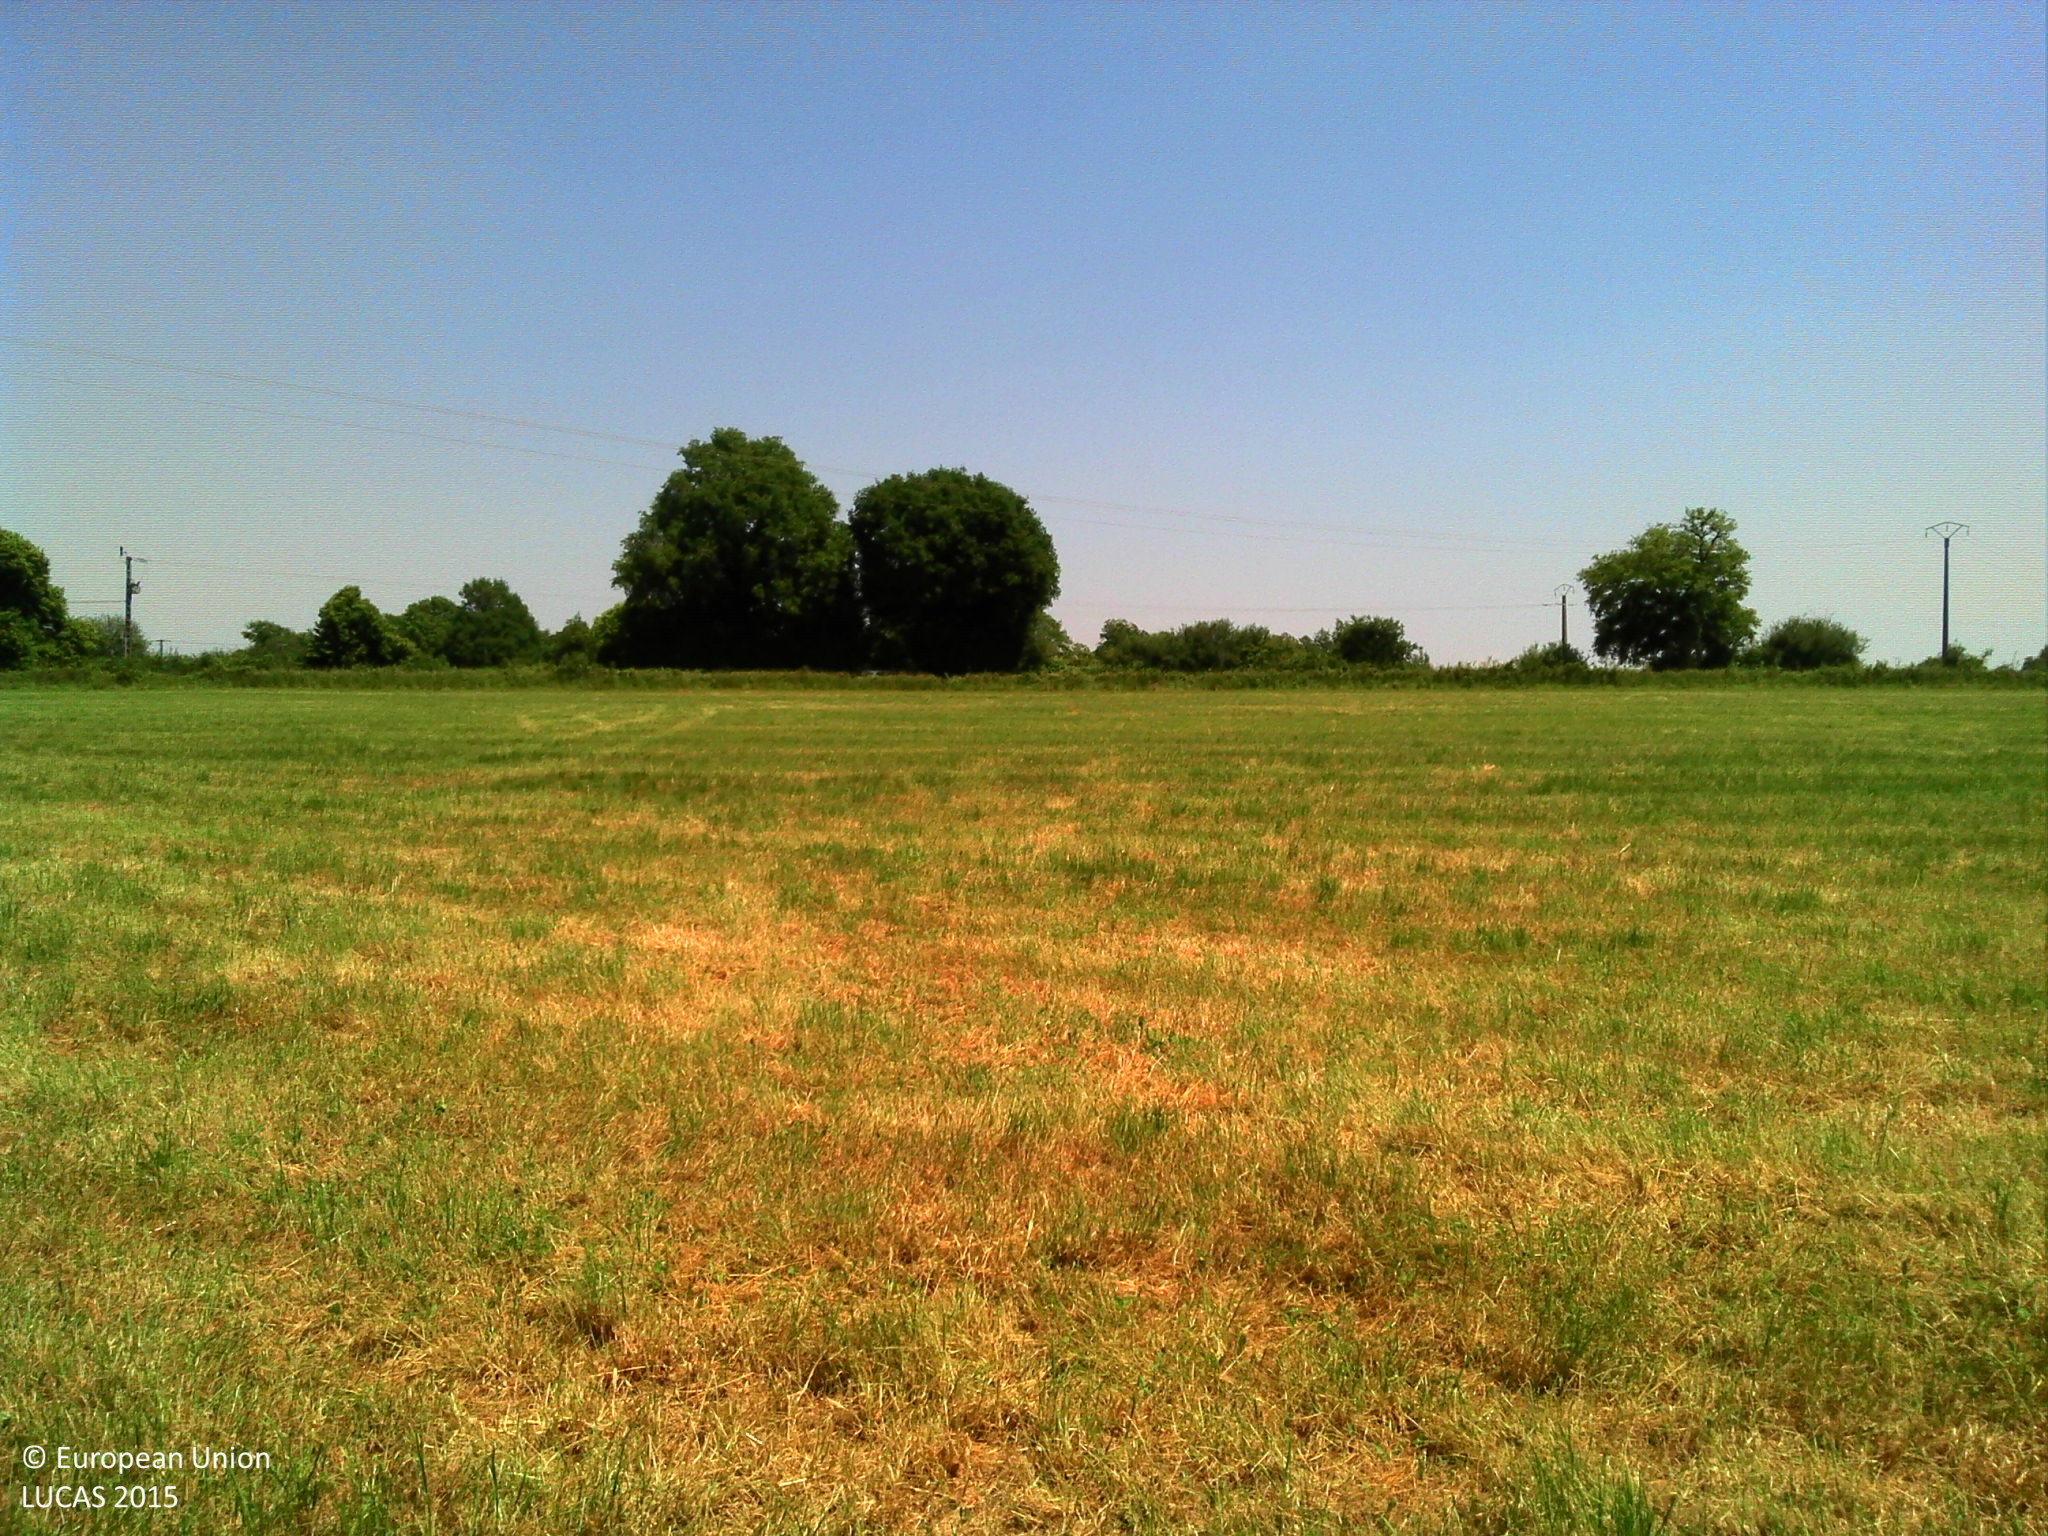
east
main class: Grassland
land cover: Grassland without tree/shrub cover
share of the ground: > 75 %
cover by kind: herbaceous plants 100 %
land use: Agriculture (excluding fallow land and kitchen gardens)
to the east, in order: Grassland without tree/shrub cover; Electric lines; Grassland without tree/shrub cover; Fences; Ditches and canals; Grass margins; Paved roads, cycling and walking lanes; Grass margins; Fences; Tracks; Managed hedges; Spontaneously vegetated surfaces; Grassland without tree/shrub cover; Electric lines; Grassland without tree/shrub cover; Electric lines; Grassland without tree/shrub cover
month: June
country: FR
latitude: 46.0778
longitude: 0.5585
